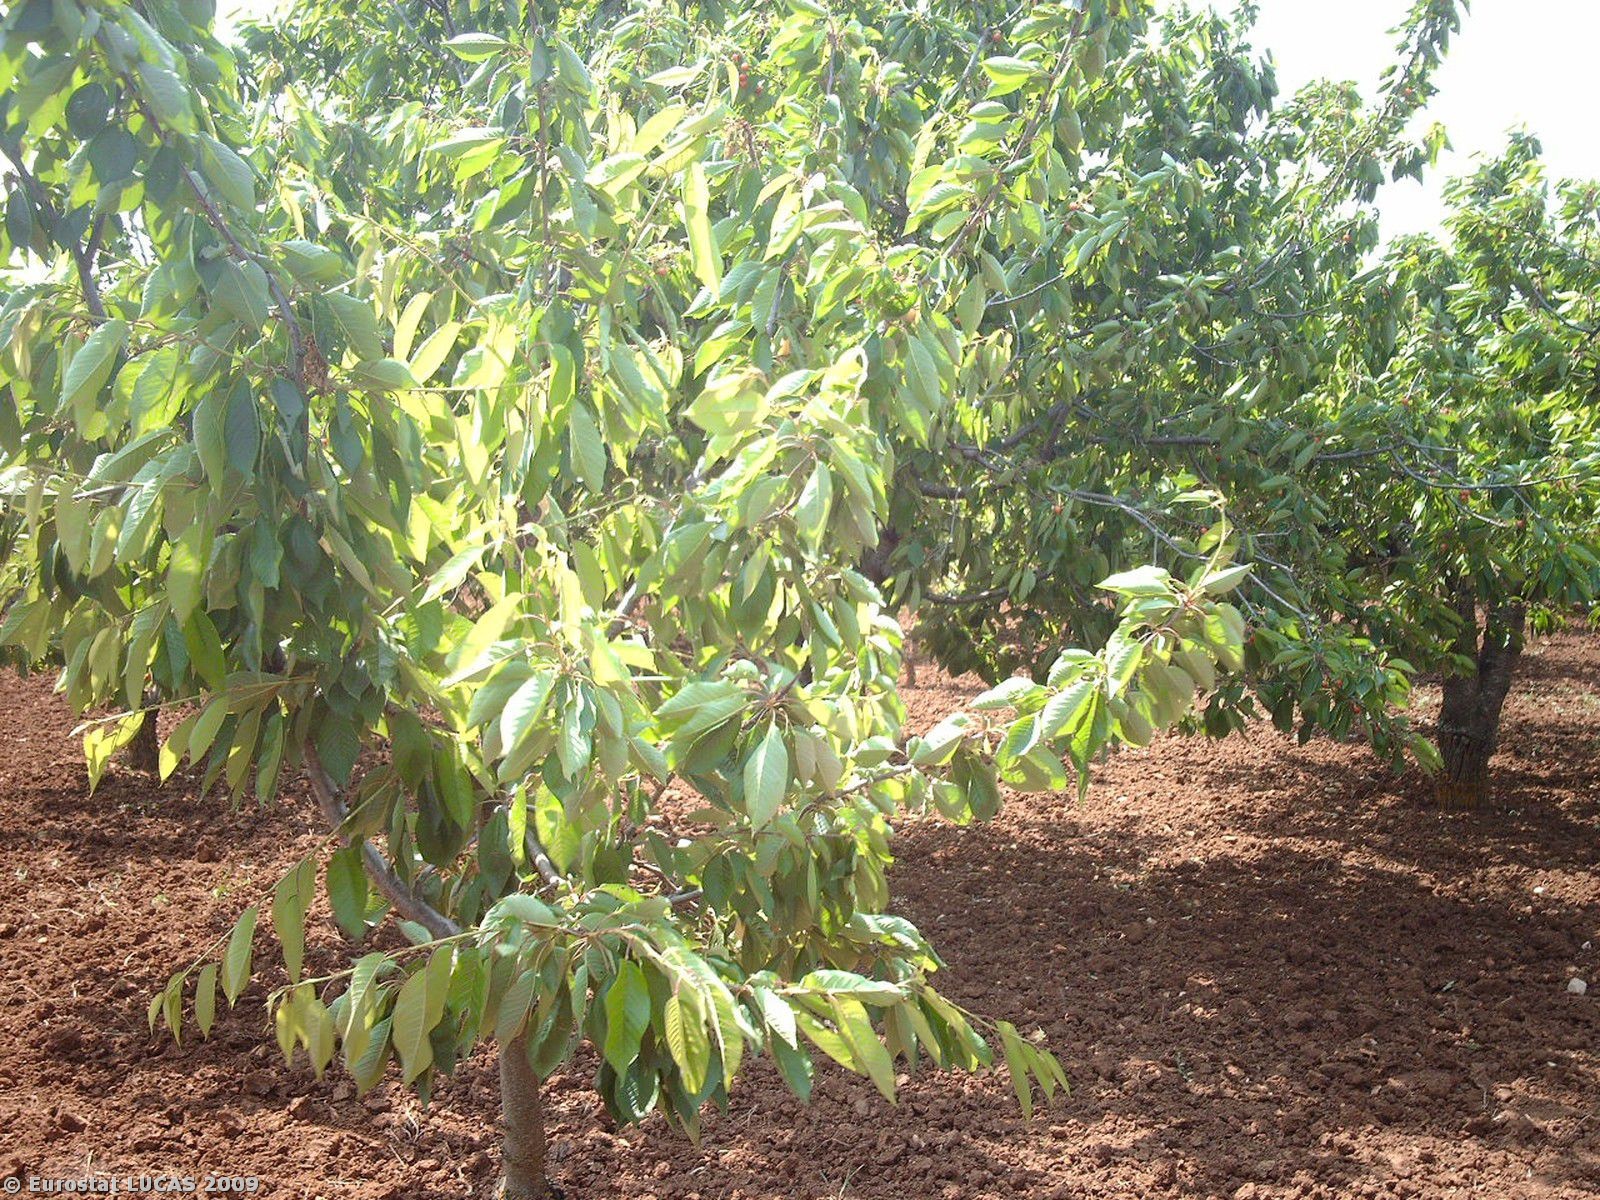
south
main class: Cropland
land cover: Cherry fruit
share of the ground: 50 - 75 %
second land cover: Olive groves
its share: 10 - 25 %
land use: Agriculture (excluding fallow land and kitchen gardens)
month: May
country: IT
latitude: 40.9070
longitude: 16.9944
